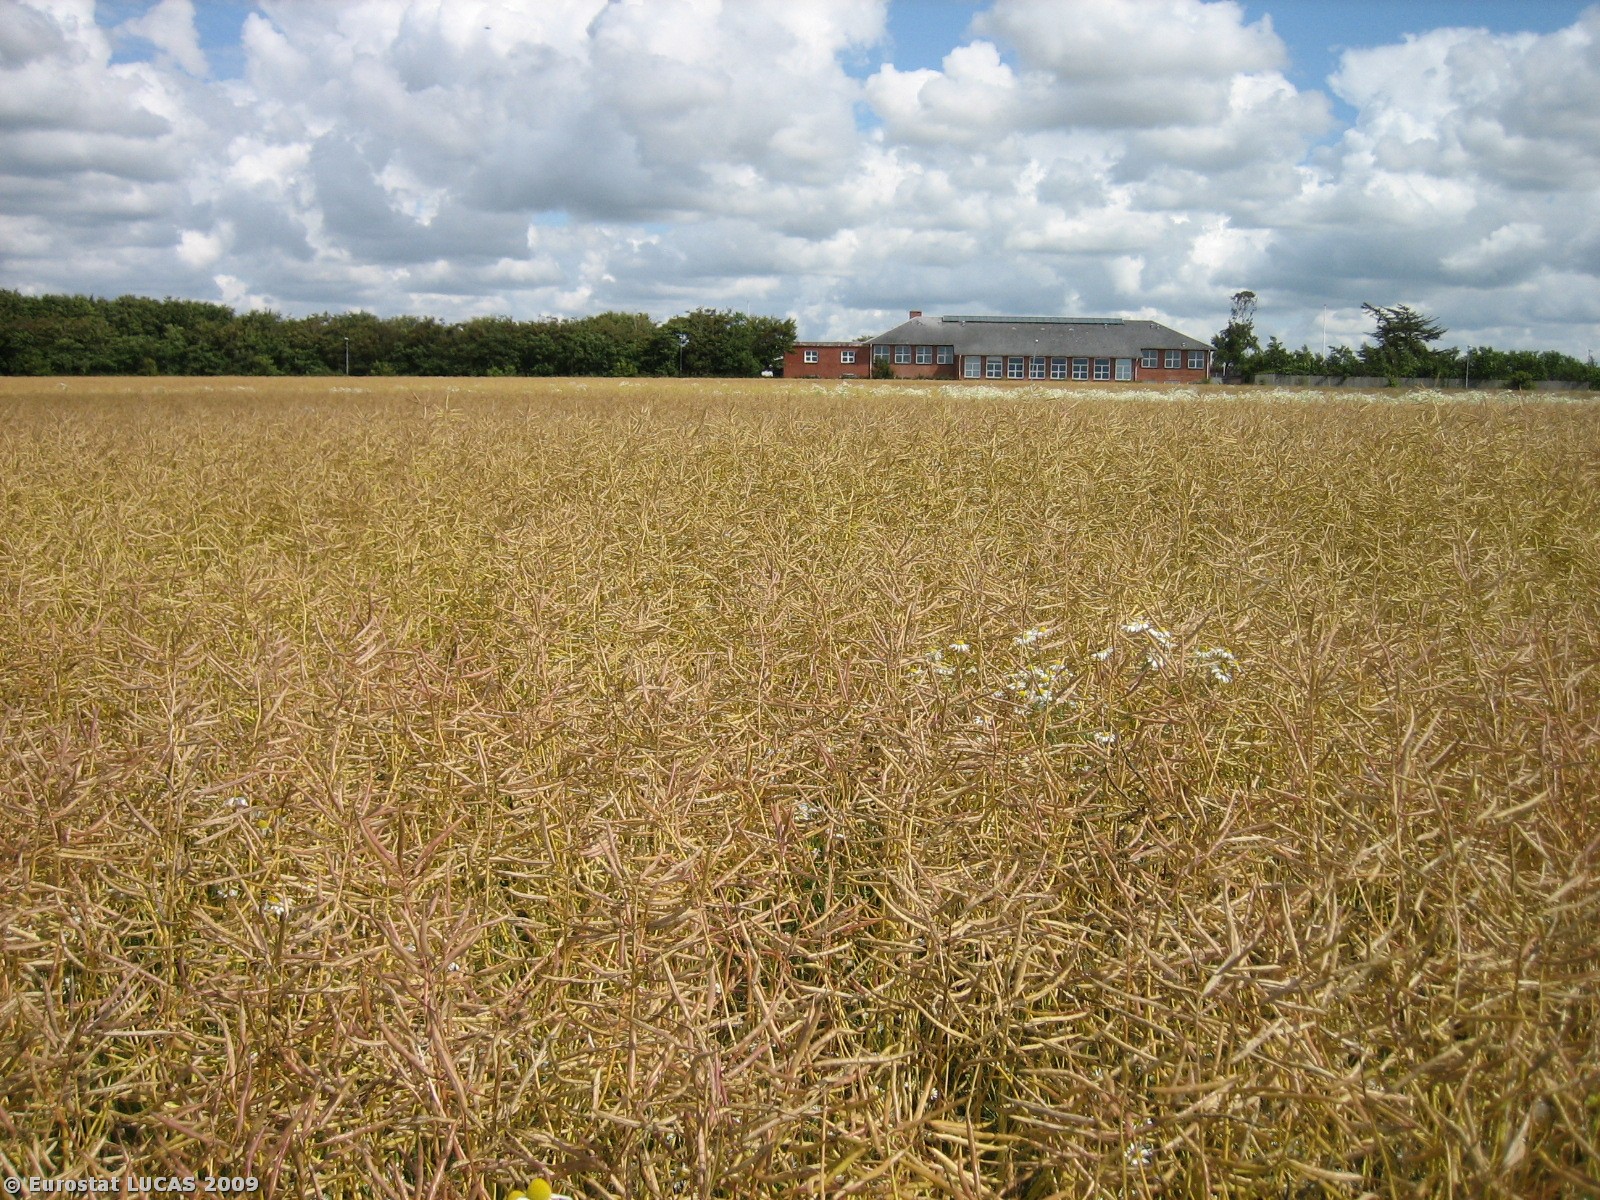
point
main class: Cropland
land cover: Rape and turnip rape
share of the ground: > 75 %
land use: Agriculture (excluding fallow land and kitchen gardens)
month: July
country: DK
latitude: 55.8013
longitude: 8.4860
